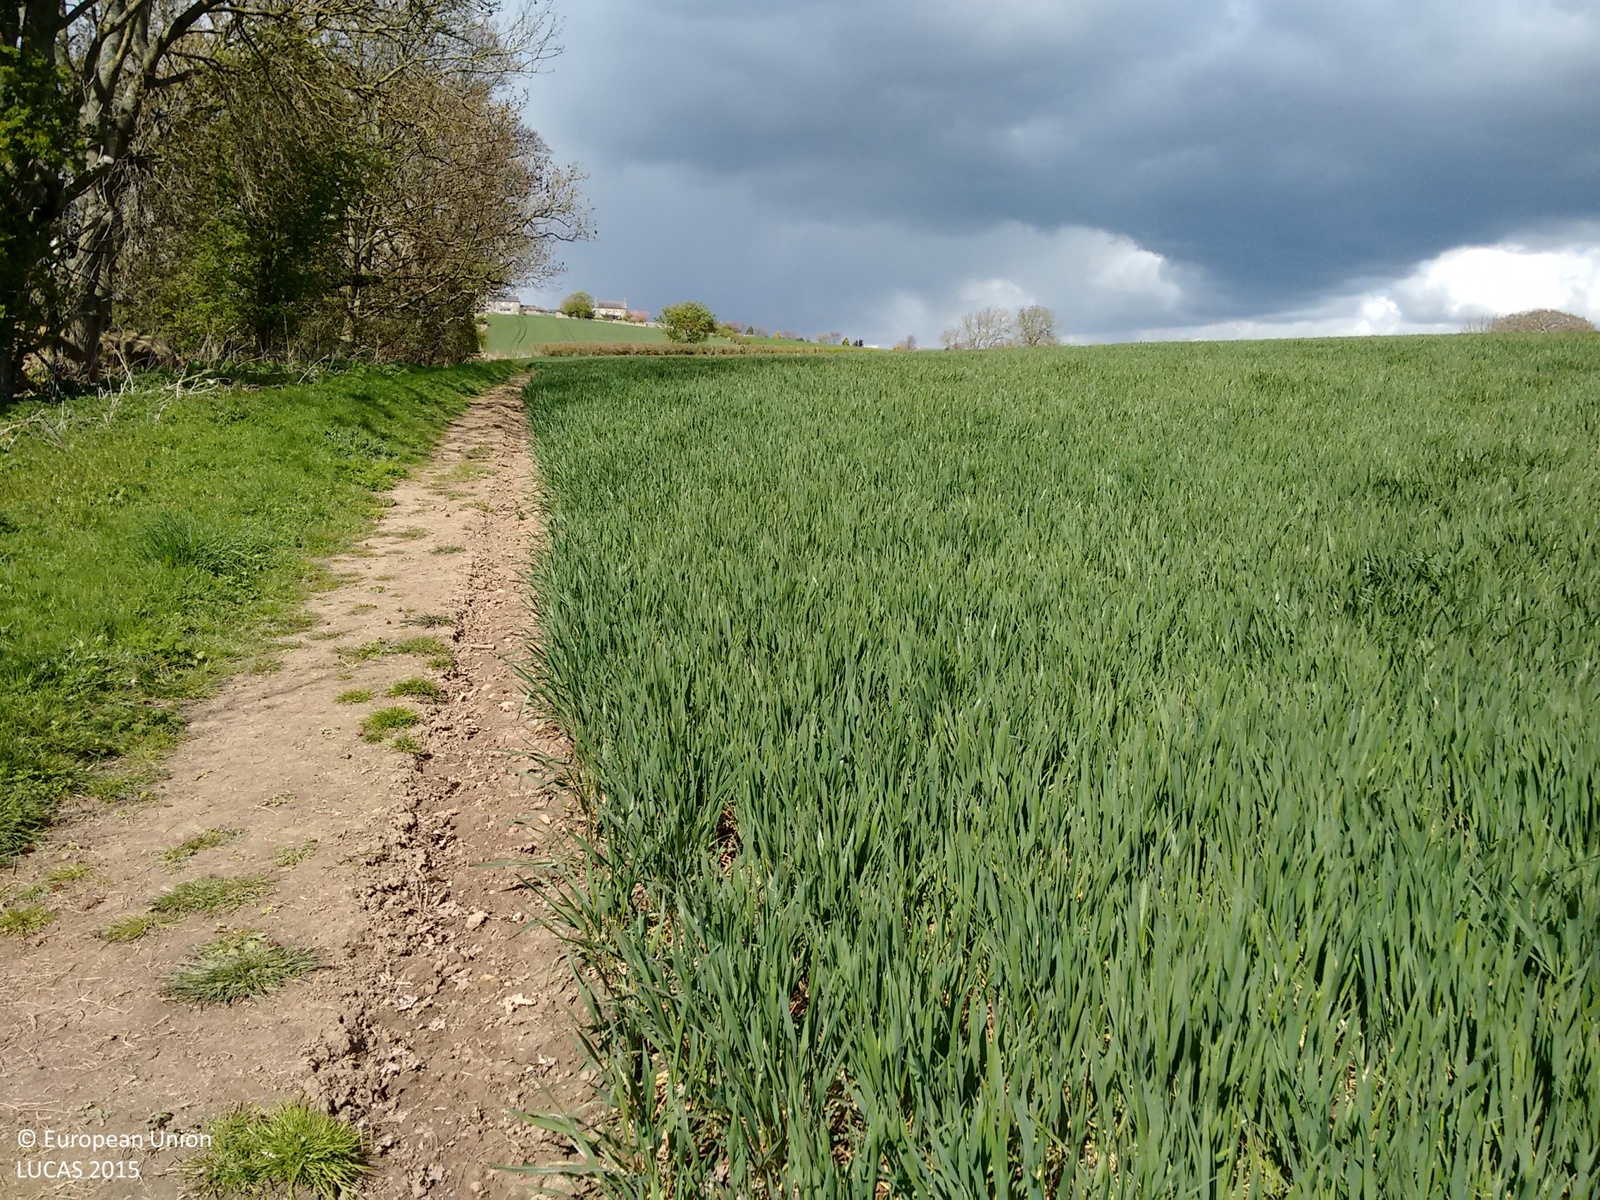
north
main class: Cropland
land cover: Common wheat
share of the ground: > 75 %
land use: Agriculture (excluding fallow land and kitchen gardens)
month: April
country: GB
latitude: 54.9786
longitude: -1.8807
